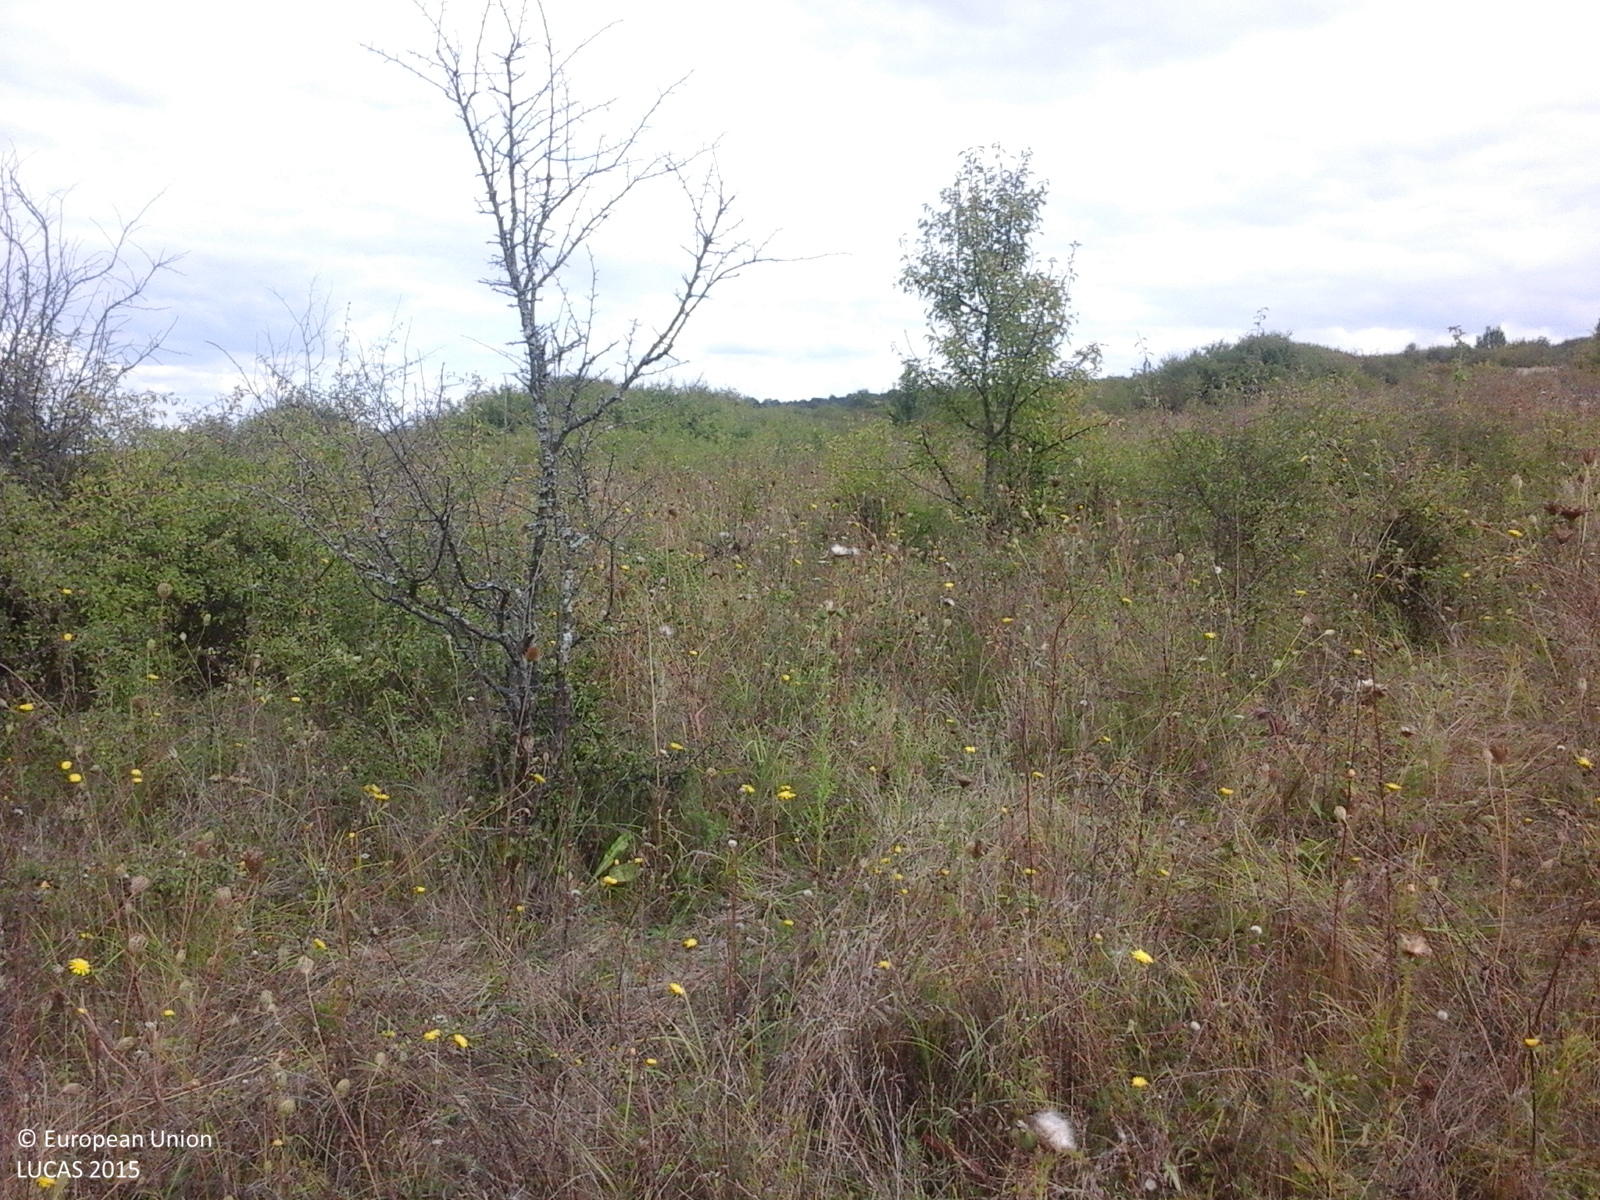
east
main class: Shrubland
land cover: Shrubland without tree cover
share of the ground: > 75 %
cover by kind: shrubs 60 %, herbaceous plants 40 %
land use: Semi-natural and natural areas not in use
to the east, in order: Shrubland without tree cover
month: September
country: RO
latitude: 47.4376
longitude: 23.1006
